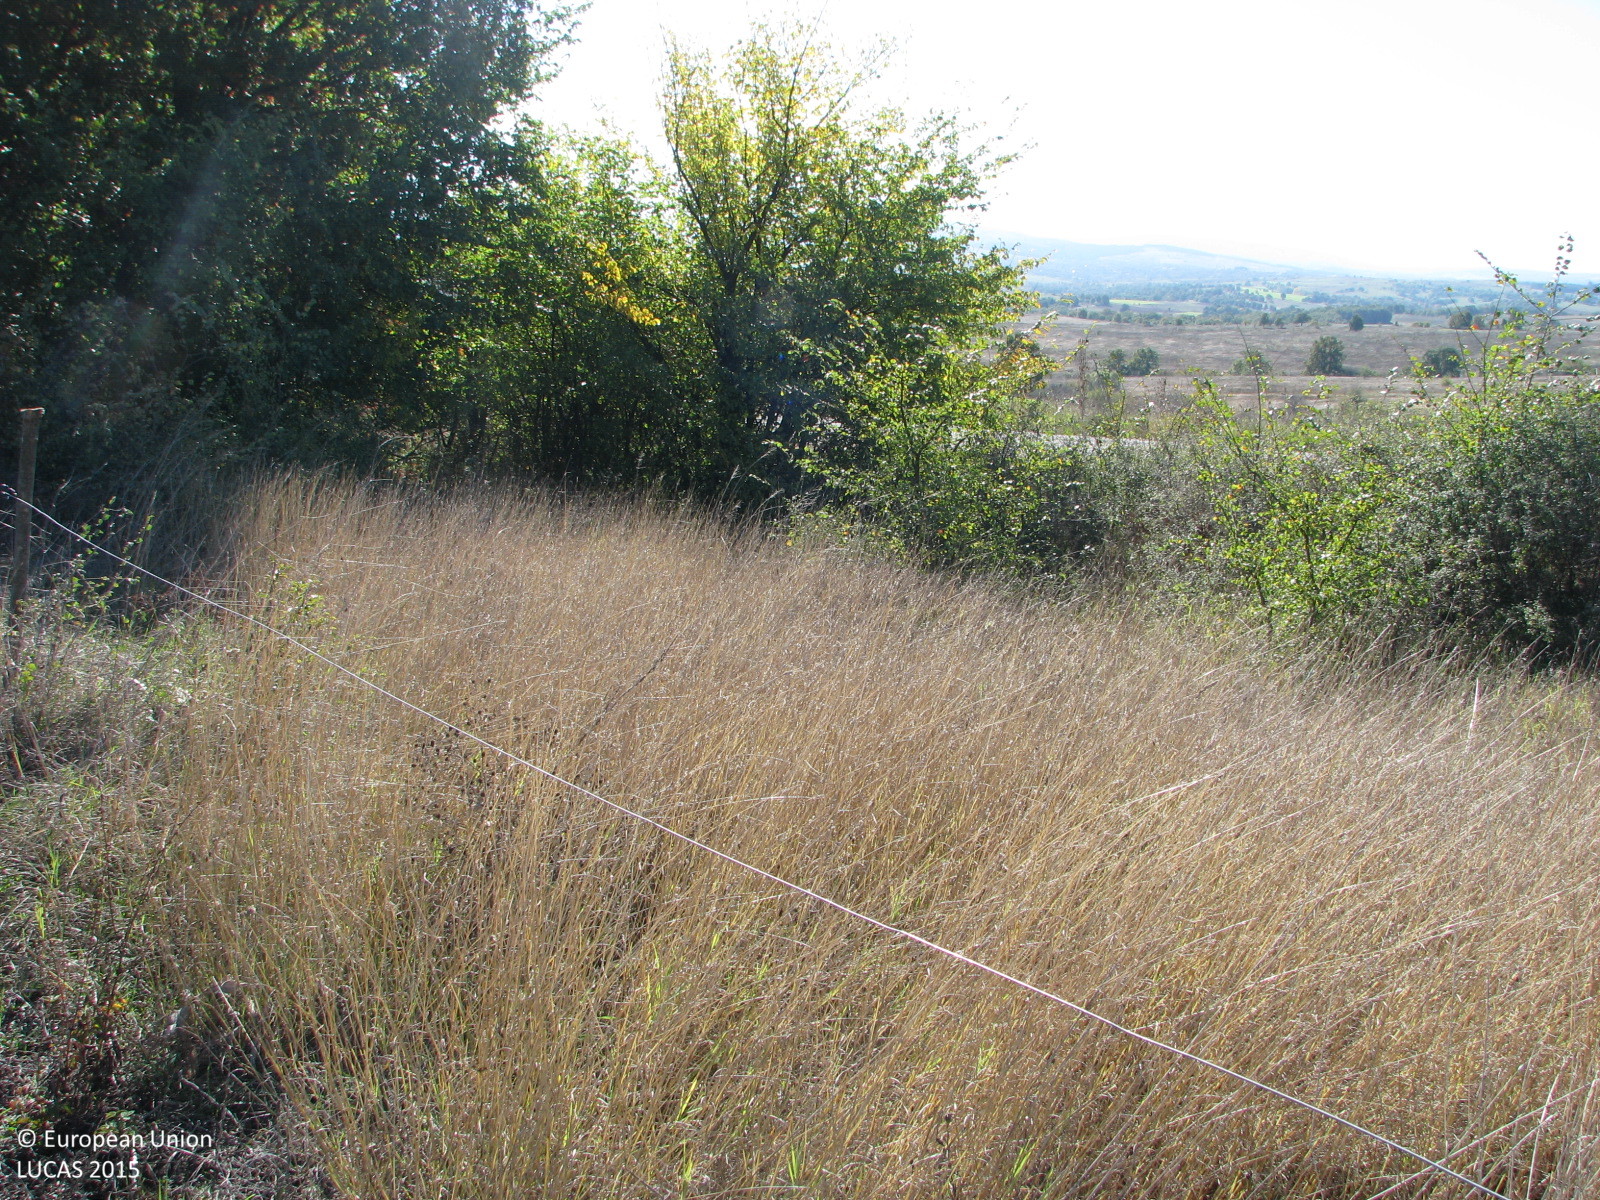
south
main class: Cropland
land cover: Common wheat
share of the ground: 25 - 50 %
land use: Agriculture (excluding fallow land and kitchen gardens)
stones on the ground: < 10 %
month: October
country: BG
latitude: 42.1214
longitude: 26.2538
